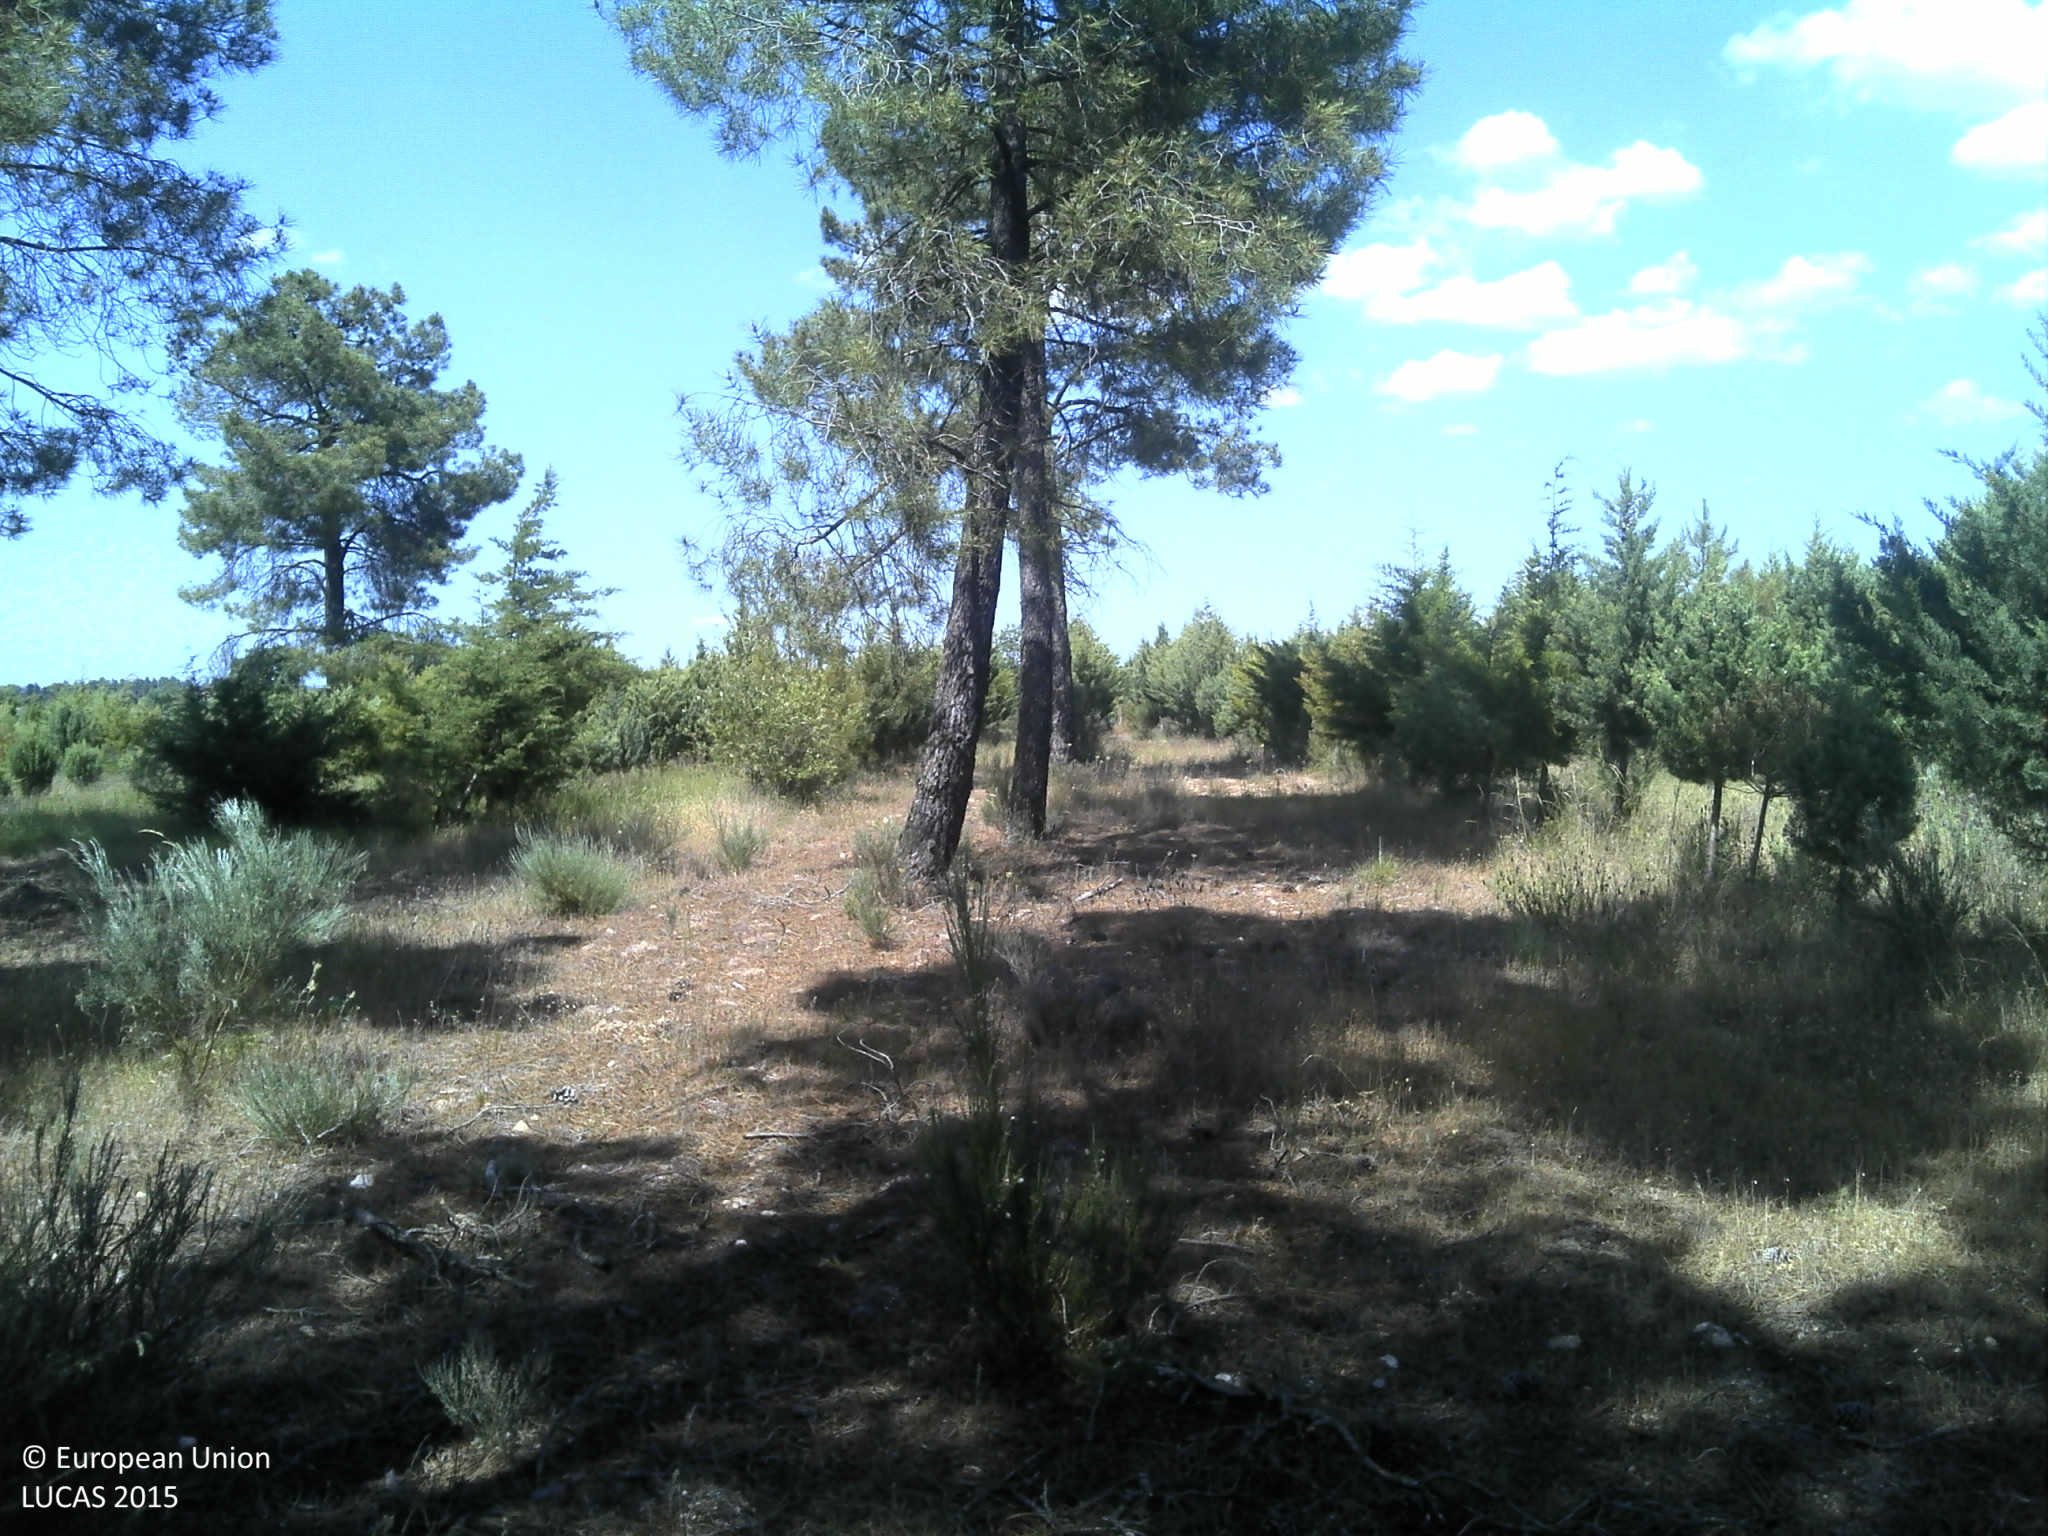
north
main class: Woodland
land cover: Pine dominated coniferous woodland
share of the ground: 50 - 75 %
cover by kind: coniferous forest trees 70 %, unconsolidated bare surface 20 %, shrubs 5 %, herbaceous plants 5 %
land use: Forestry
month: June
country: PT
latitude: 40.7109
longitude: -6.8722
